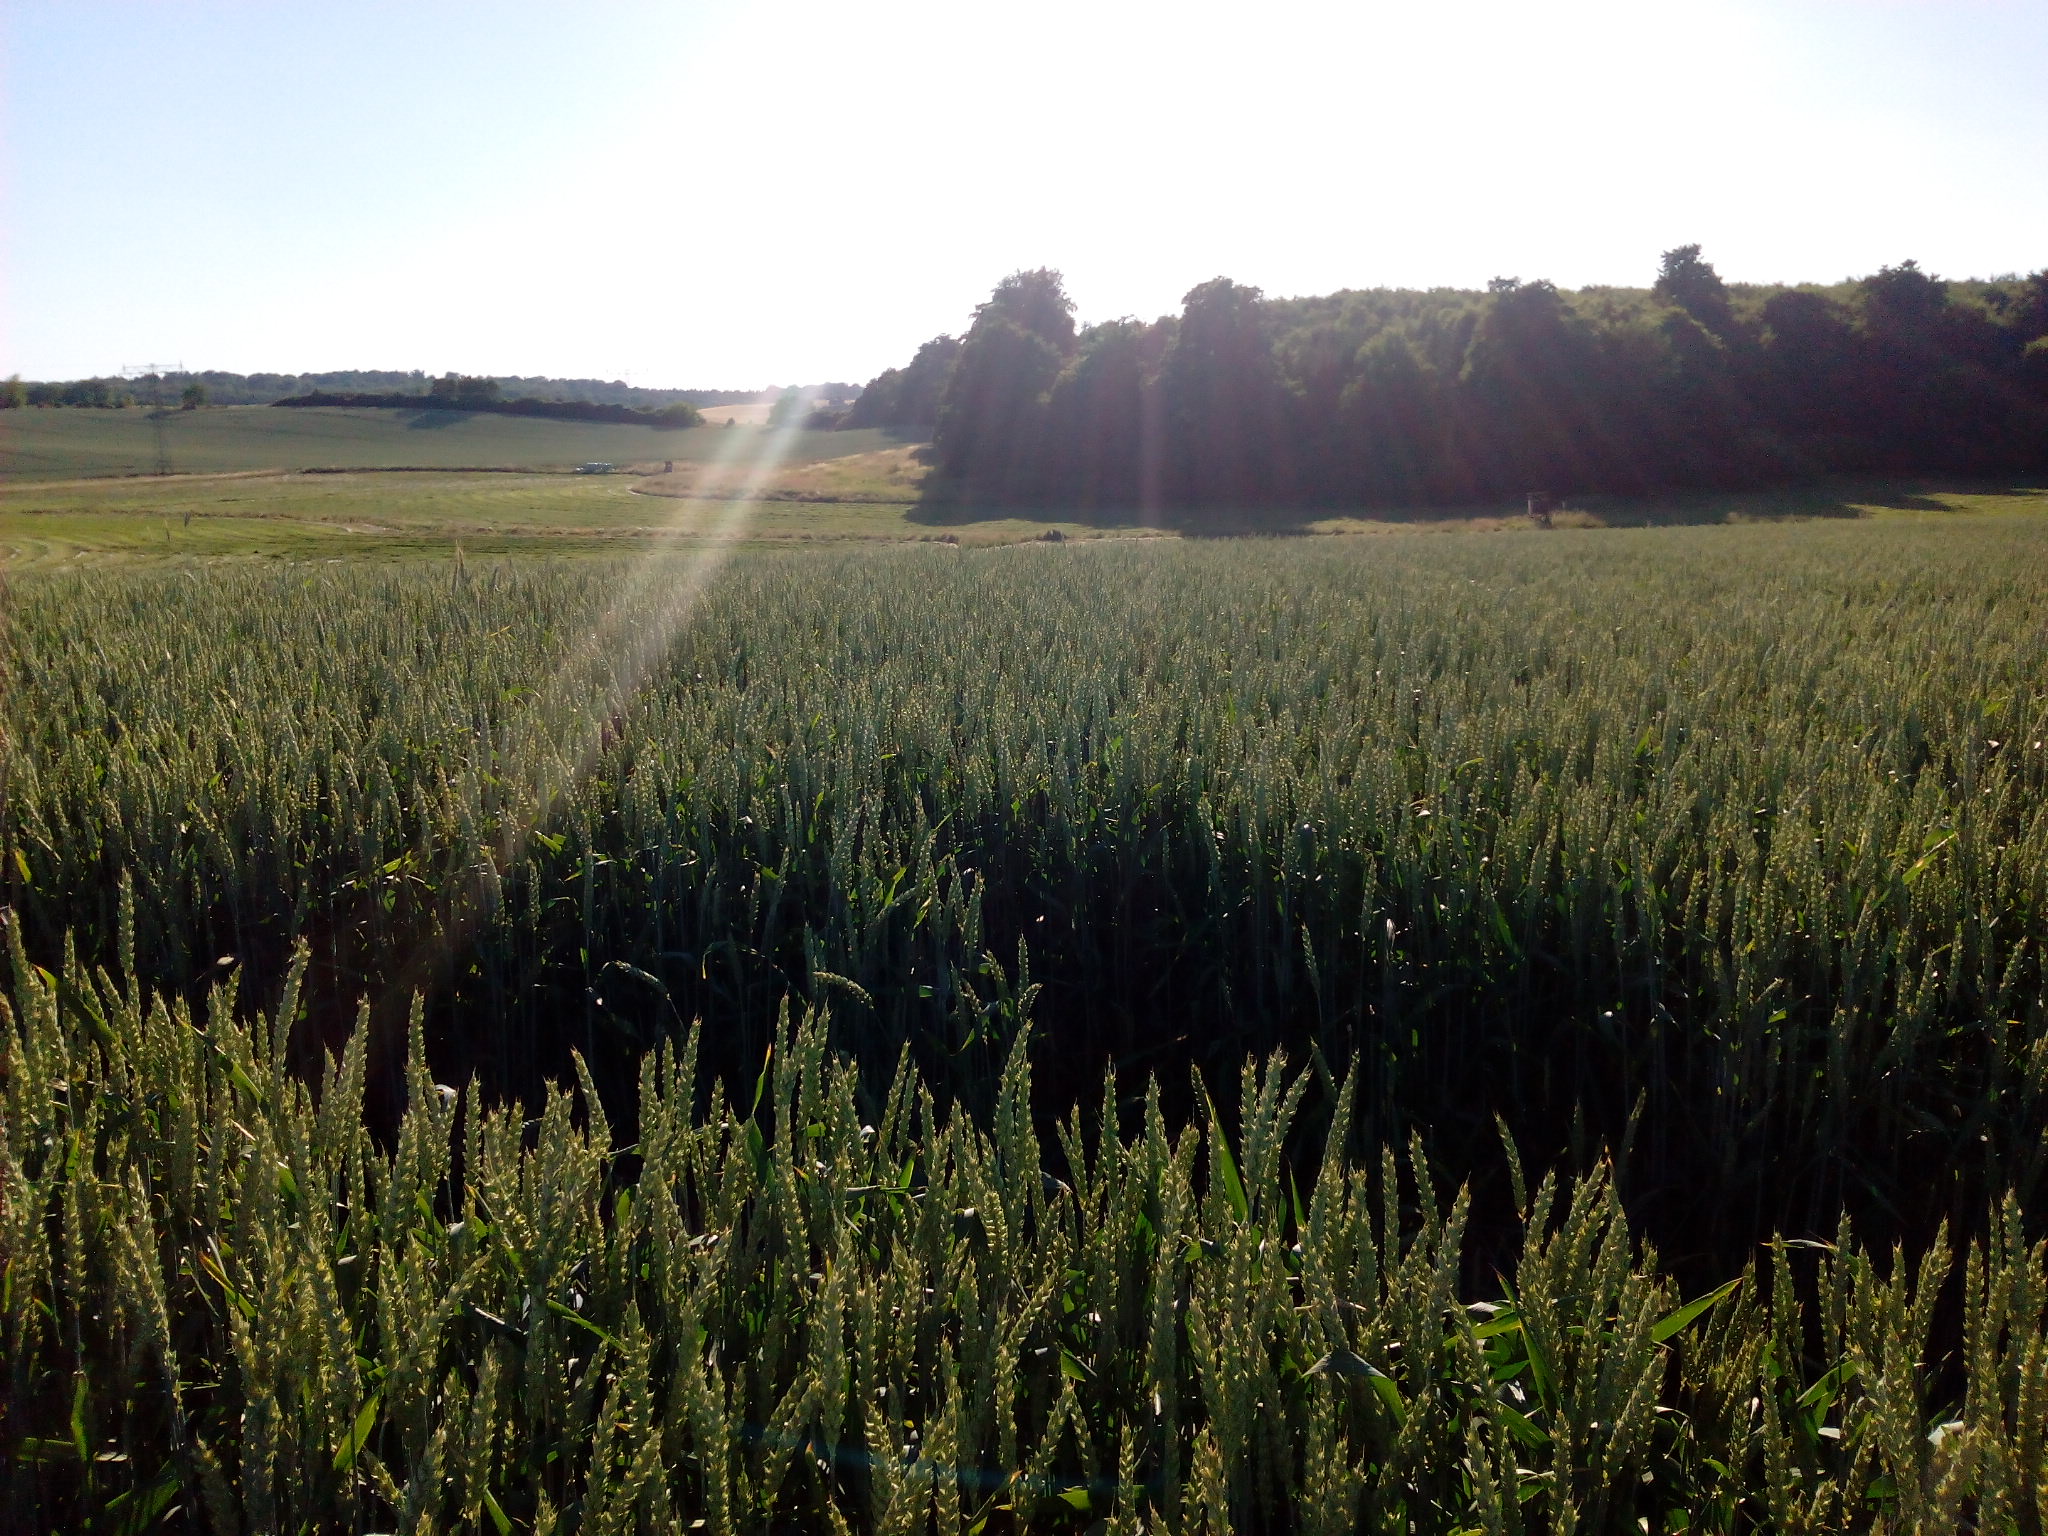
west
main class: Cropland
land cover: Common wheat
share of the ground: > 75 %
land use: Agriculture (excluding fallow land and kitchen gardens)
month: July
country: DE
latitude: 53.4315
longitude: 13.2055
